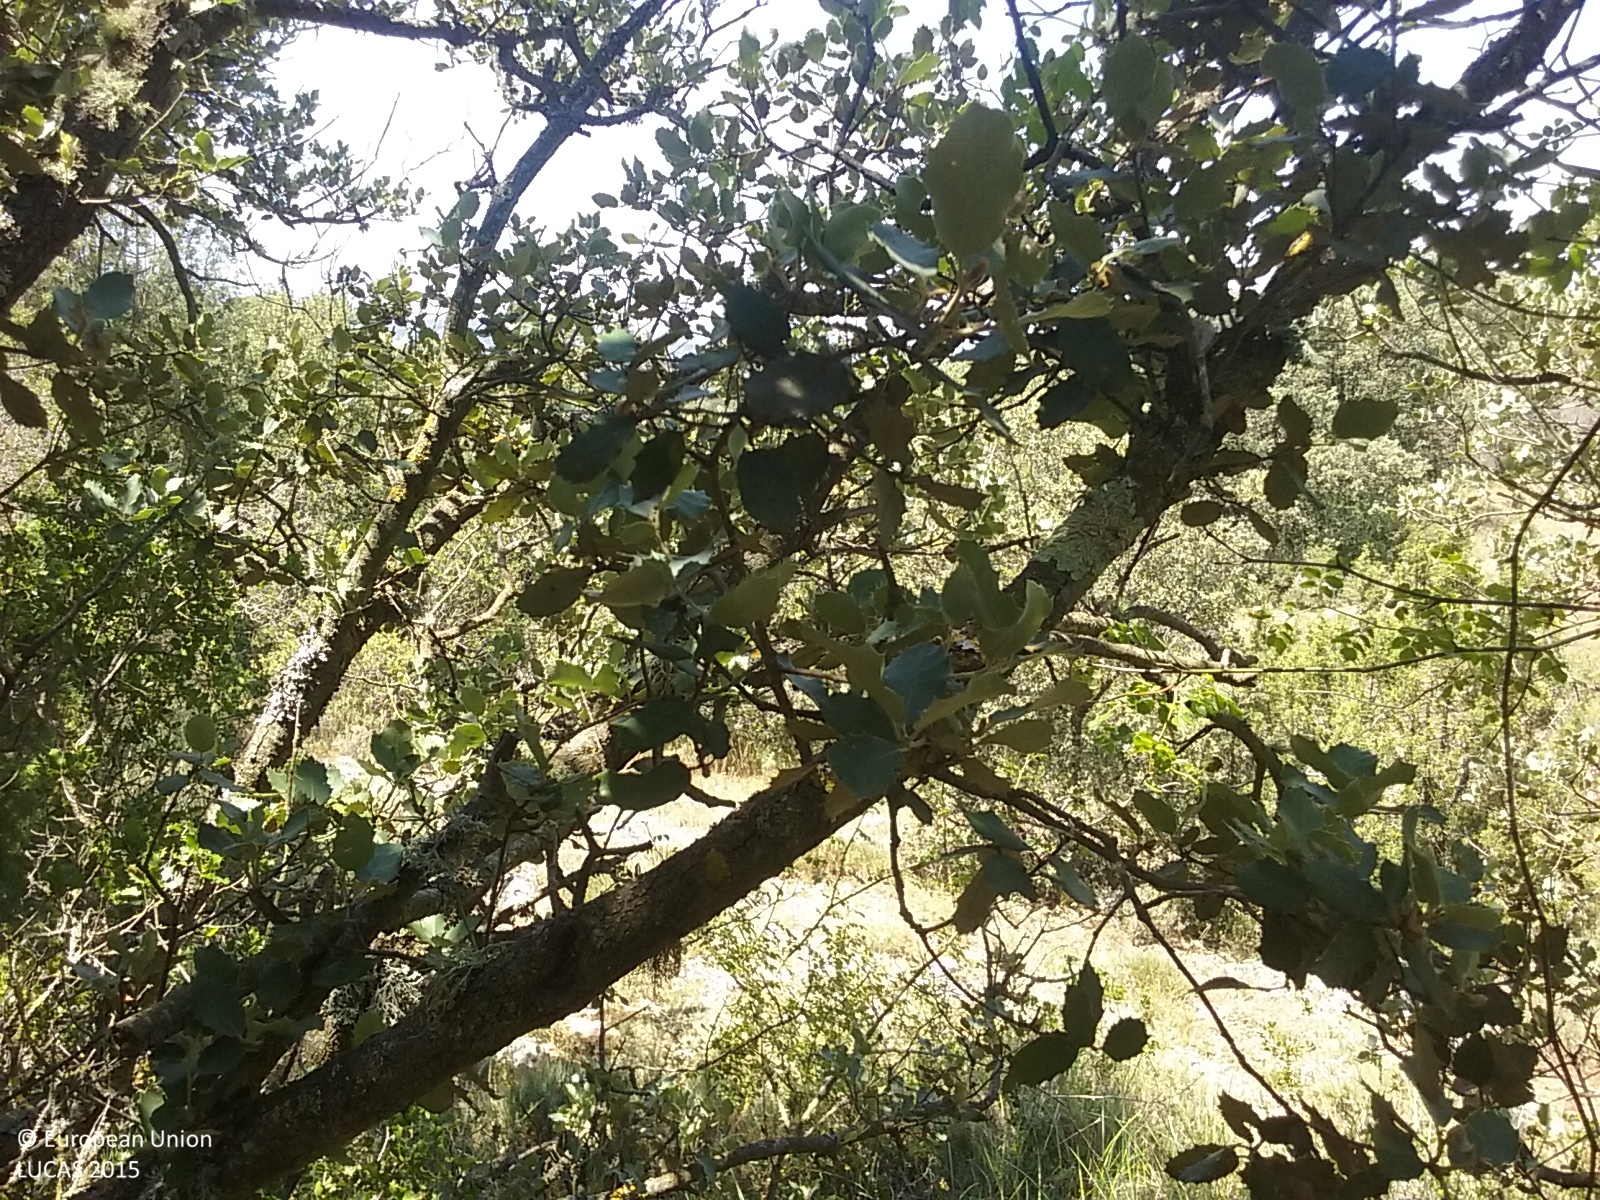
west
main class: Woodland
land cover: Broadleaved woodland
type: broadleaved evergreen forest
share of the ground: > 75 %
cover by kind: broadleaved forest trees 95 %, herbaceous plants 5 %
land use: Semi-natural and natural areas not in use
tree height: < 5 m
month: July
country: ES
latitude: 39.9524
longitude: -0.7143
